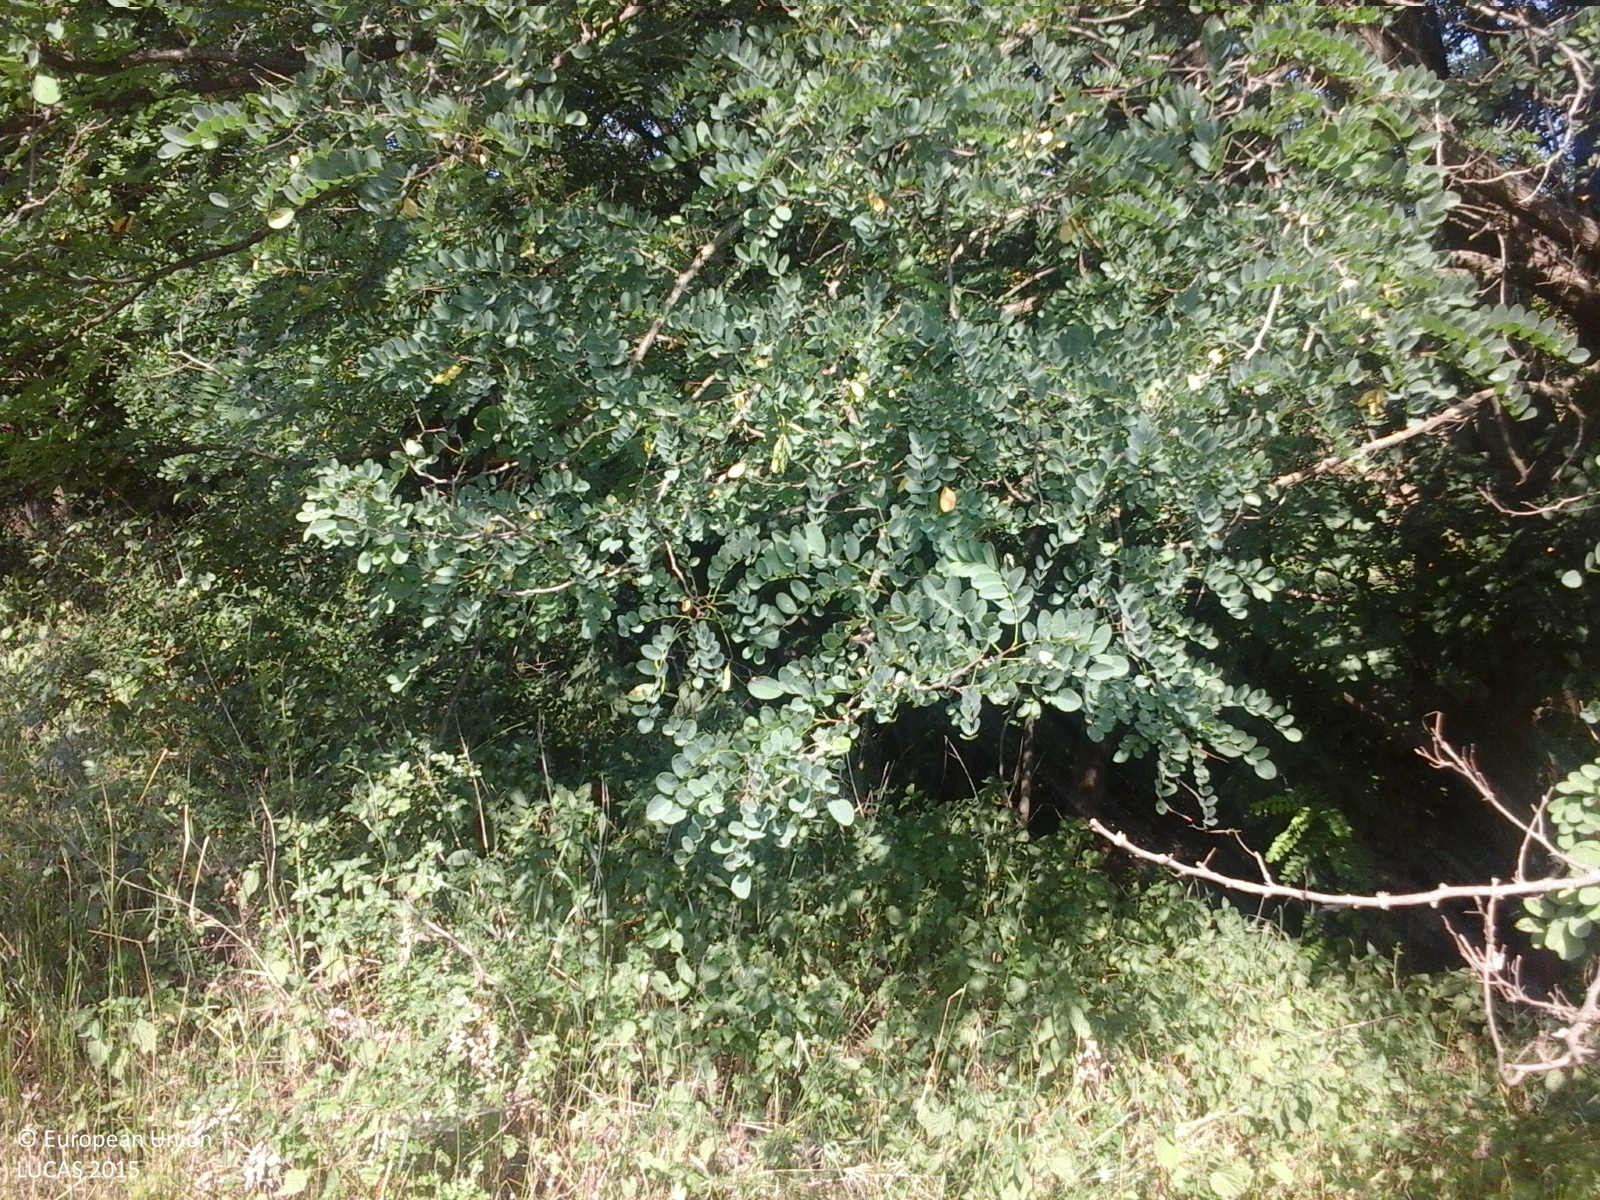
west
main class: Grassland
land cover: Grassland without tree/shrub cover
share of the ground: > 75 %
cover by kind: herbaceous plants 100 %
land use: Agriculture (excluding fallow land and kitchen gardens)
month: July
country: RO
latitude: 46.5495
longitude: 27.1734
